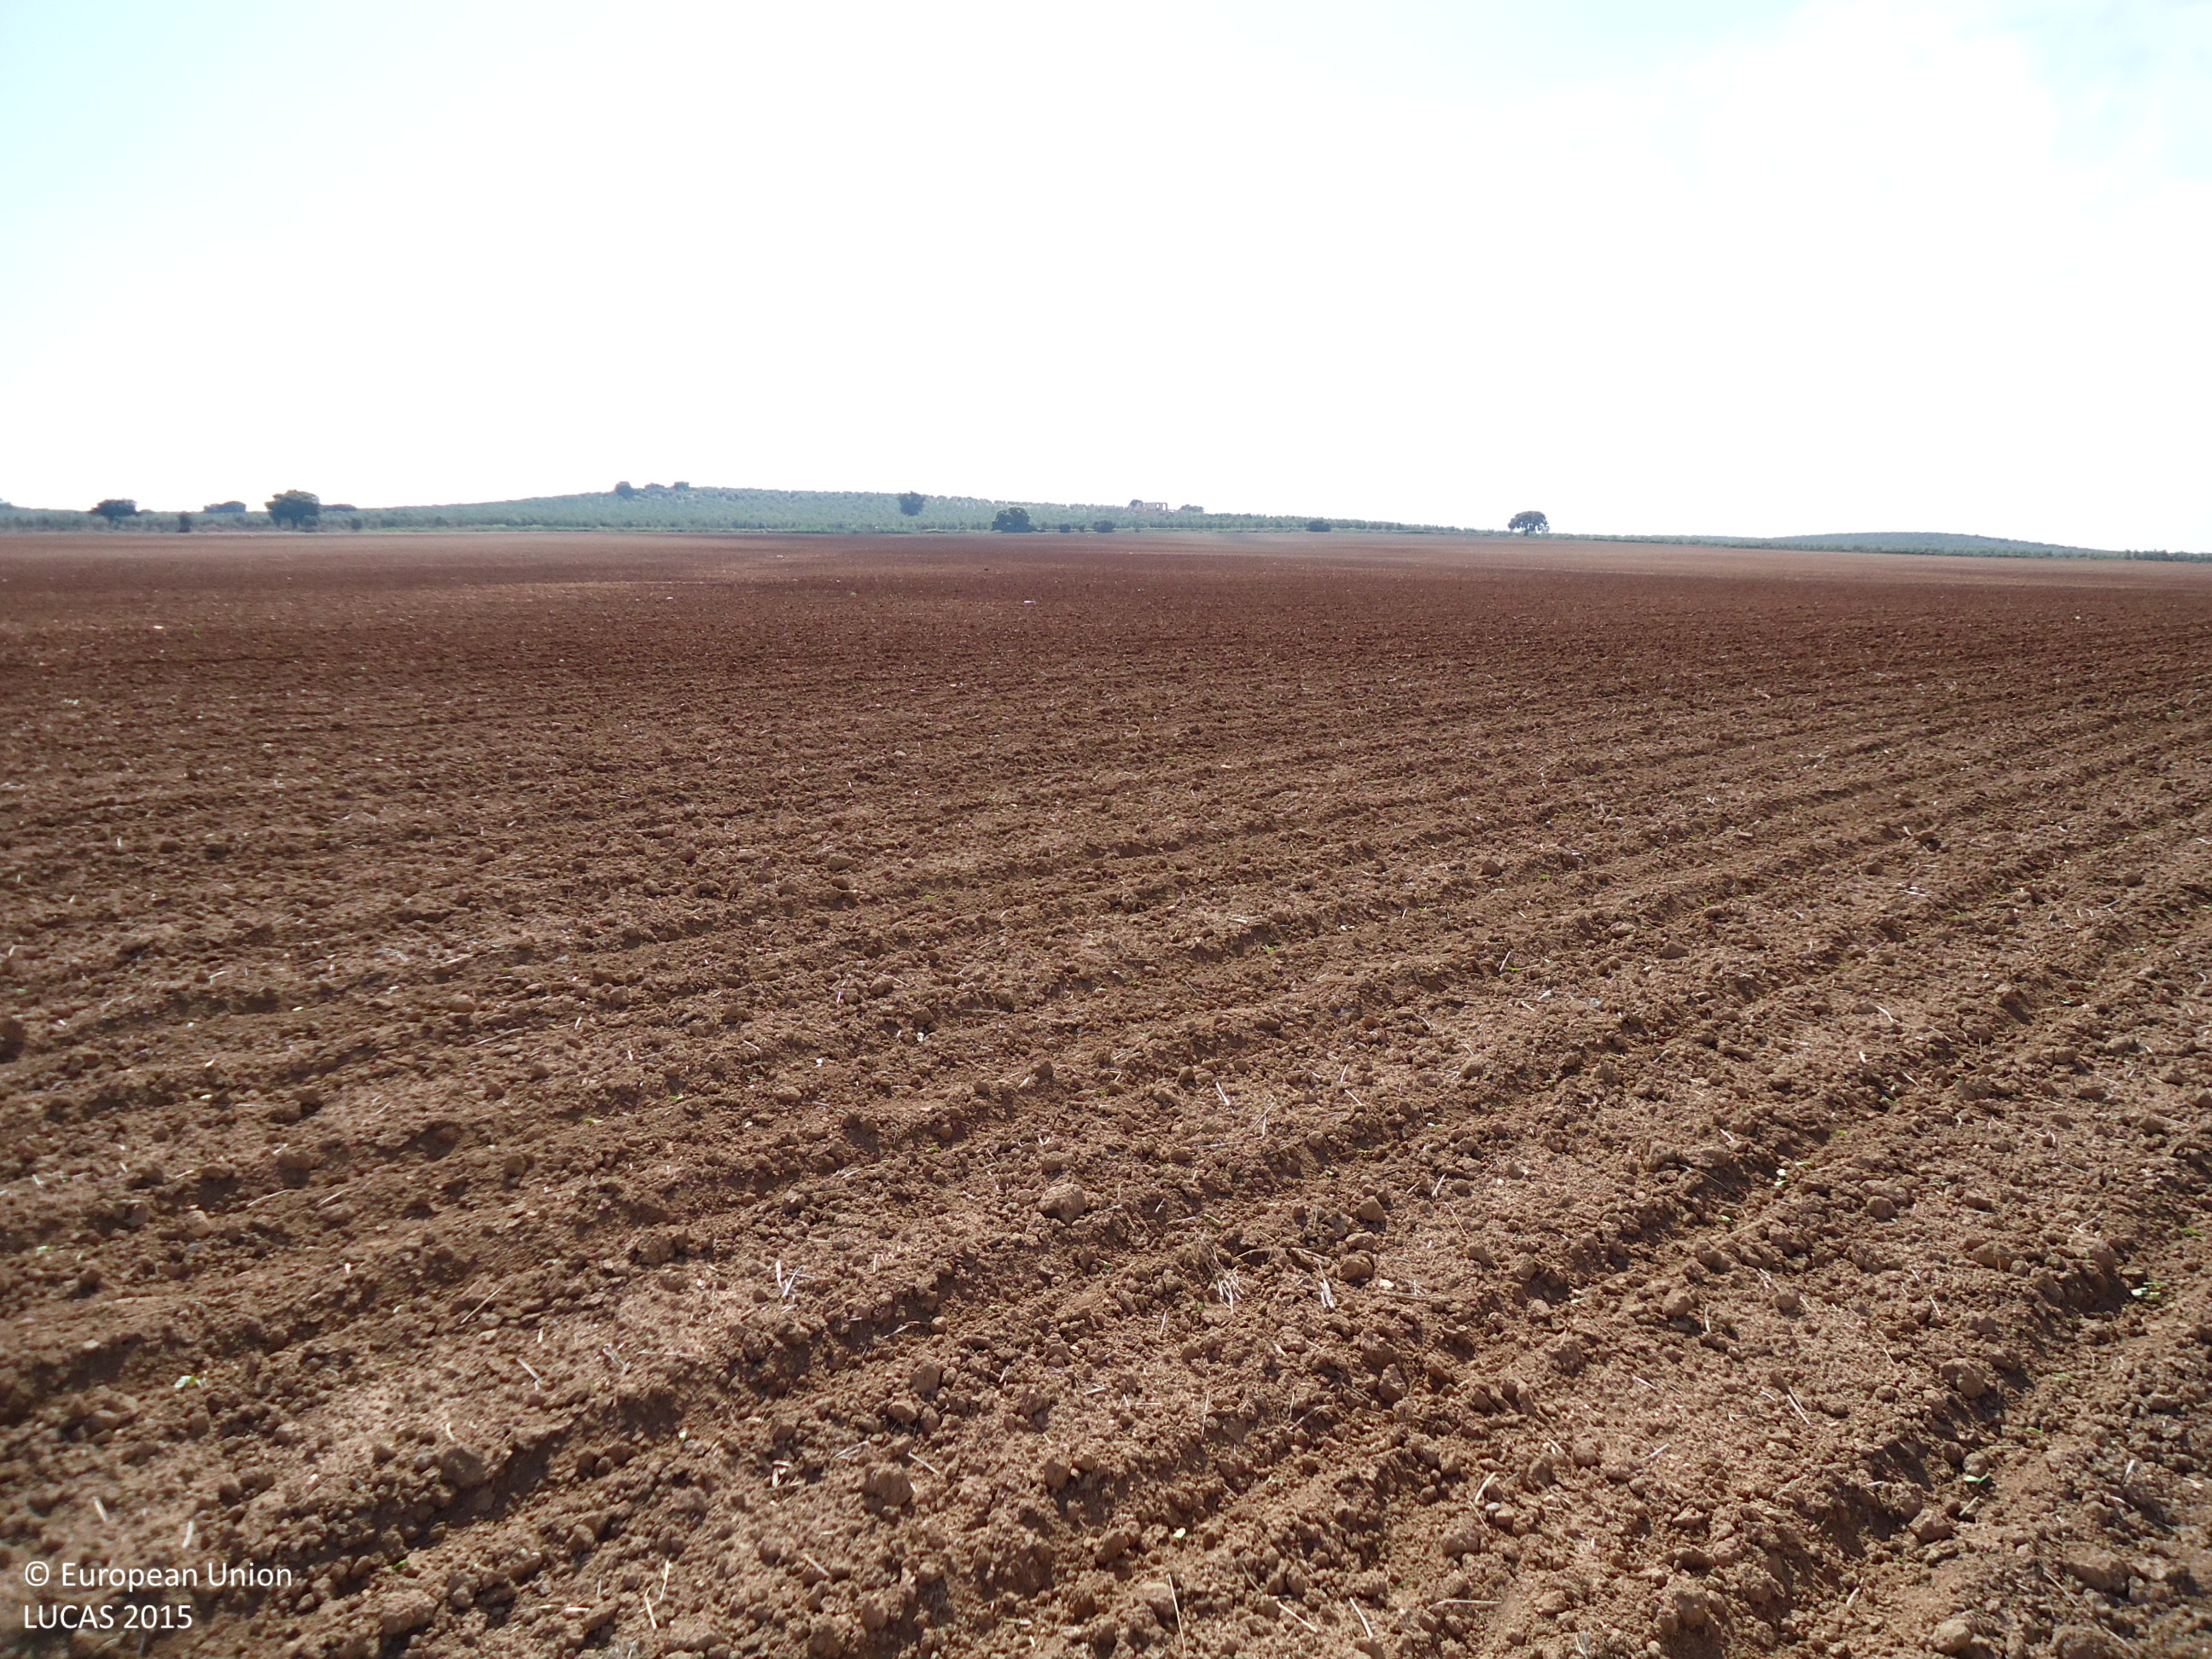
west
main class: Cropland
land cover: Sunflower
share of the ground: < 10 %
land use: Agriculture (excluding fallow land and kitchen gardens)
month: April
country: ES
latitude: 37.0983
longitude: -4.7967
